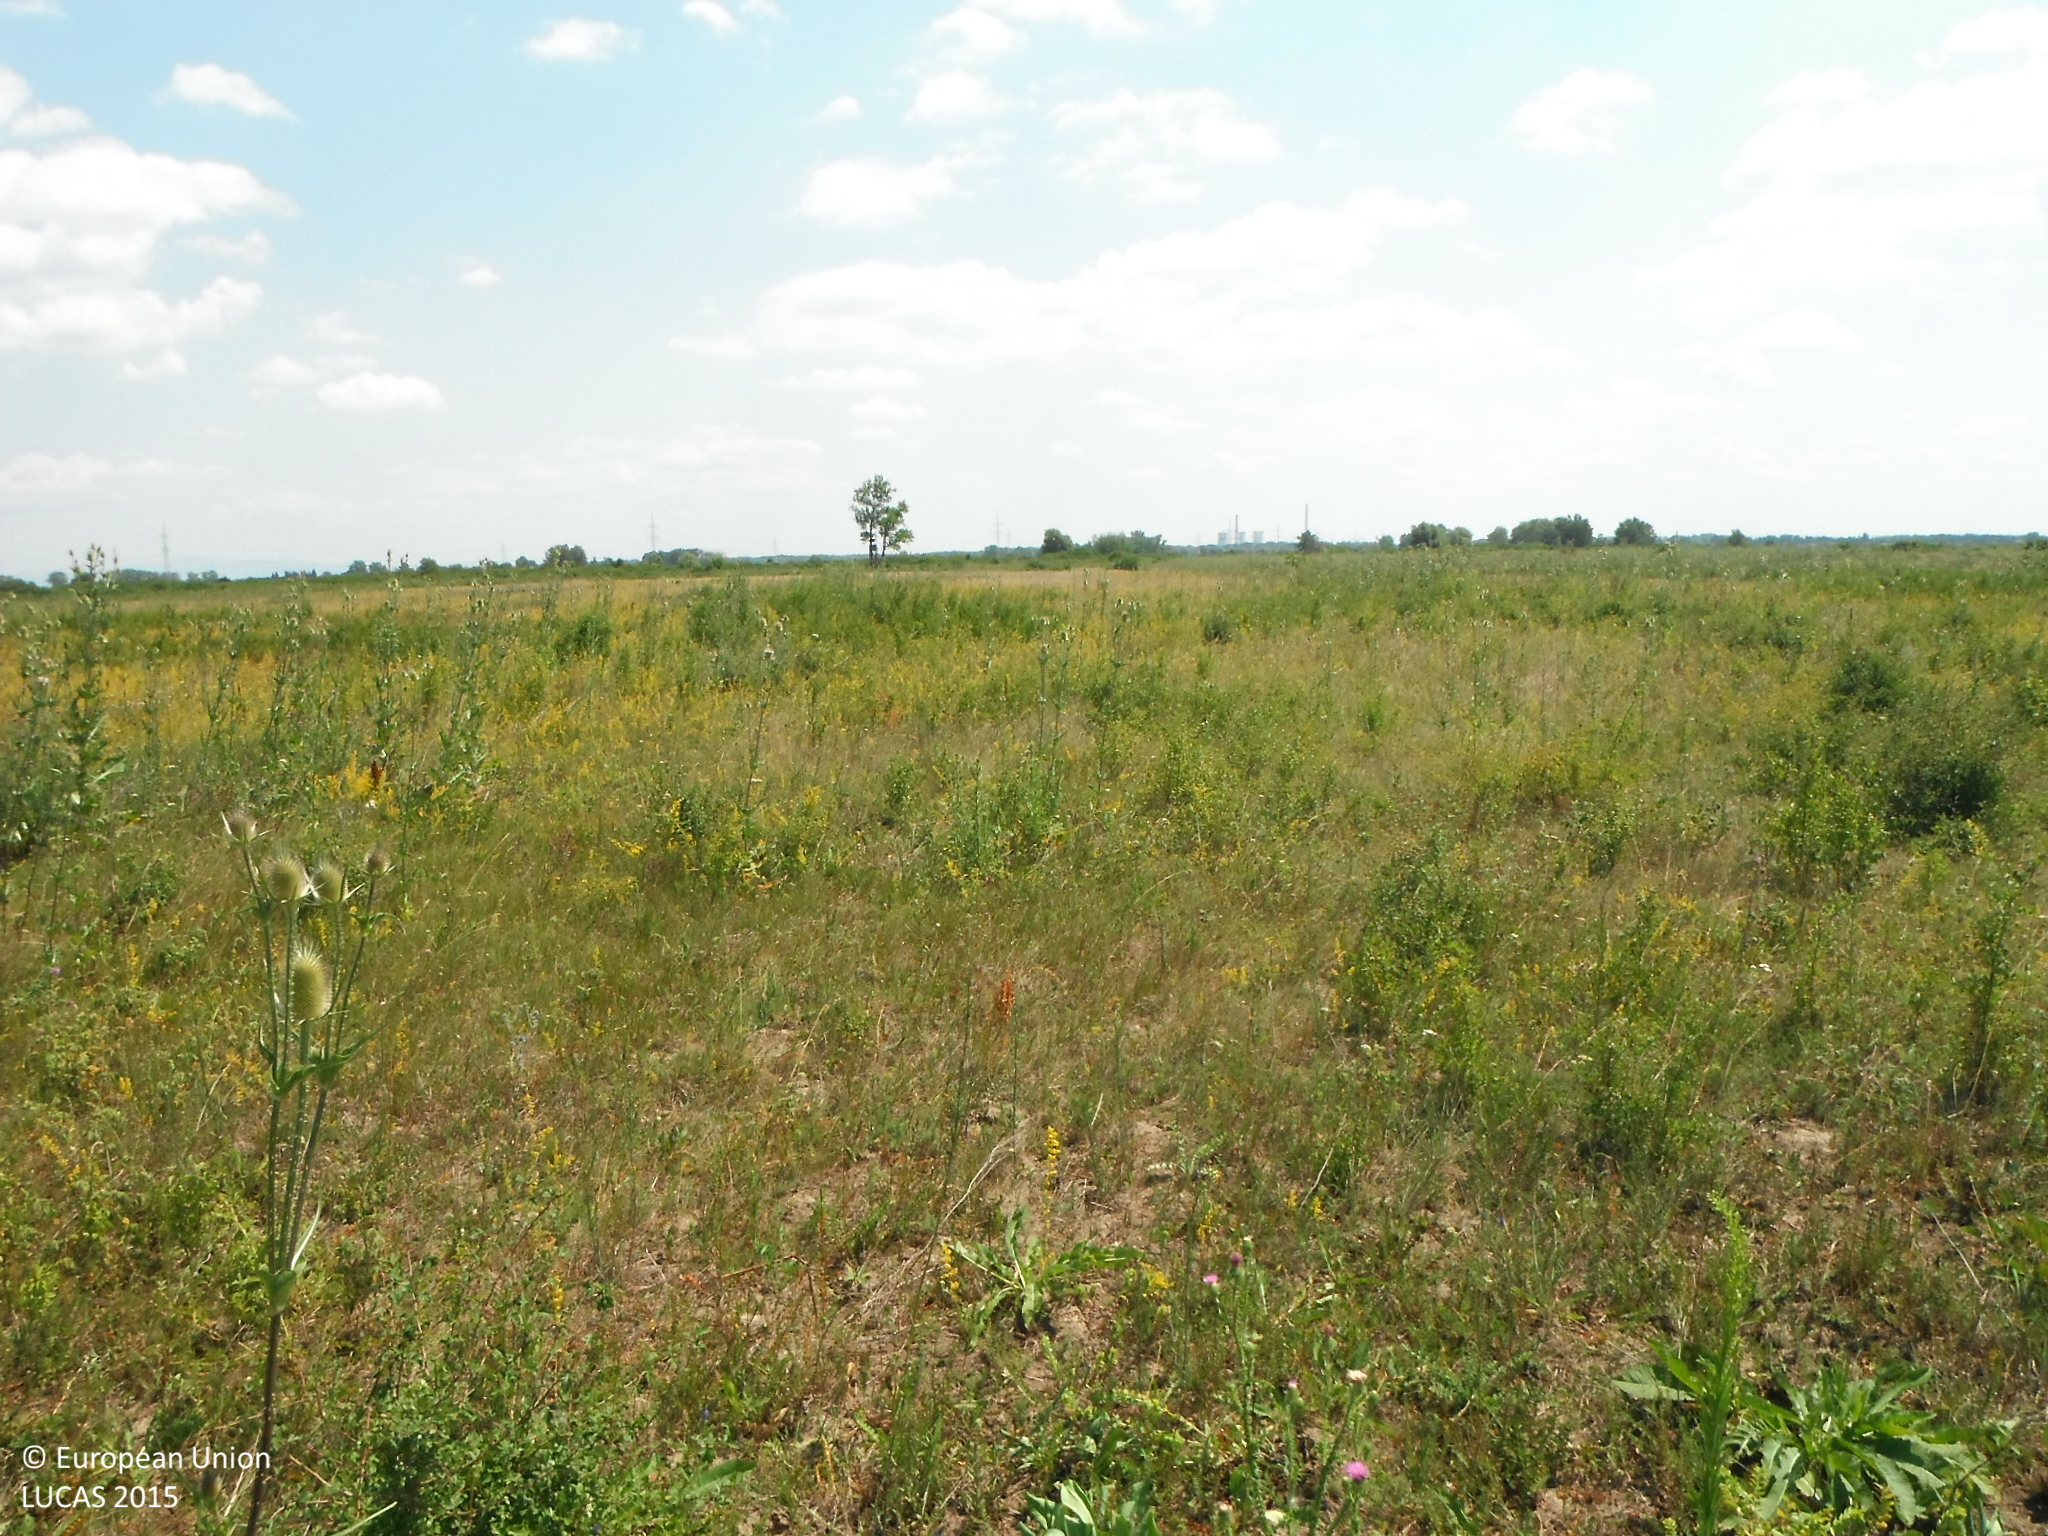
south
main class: Grassland
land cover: Spontaneously vegetated surfaces
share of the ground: > 75 %
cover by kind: herbaceous plants 100 %
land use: Agriculture (excluding fallow land and kitchen gardens)
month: July
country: SK
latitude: 48.5781
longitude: 21.8858
